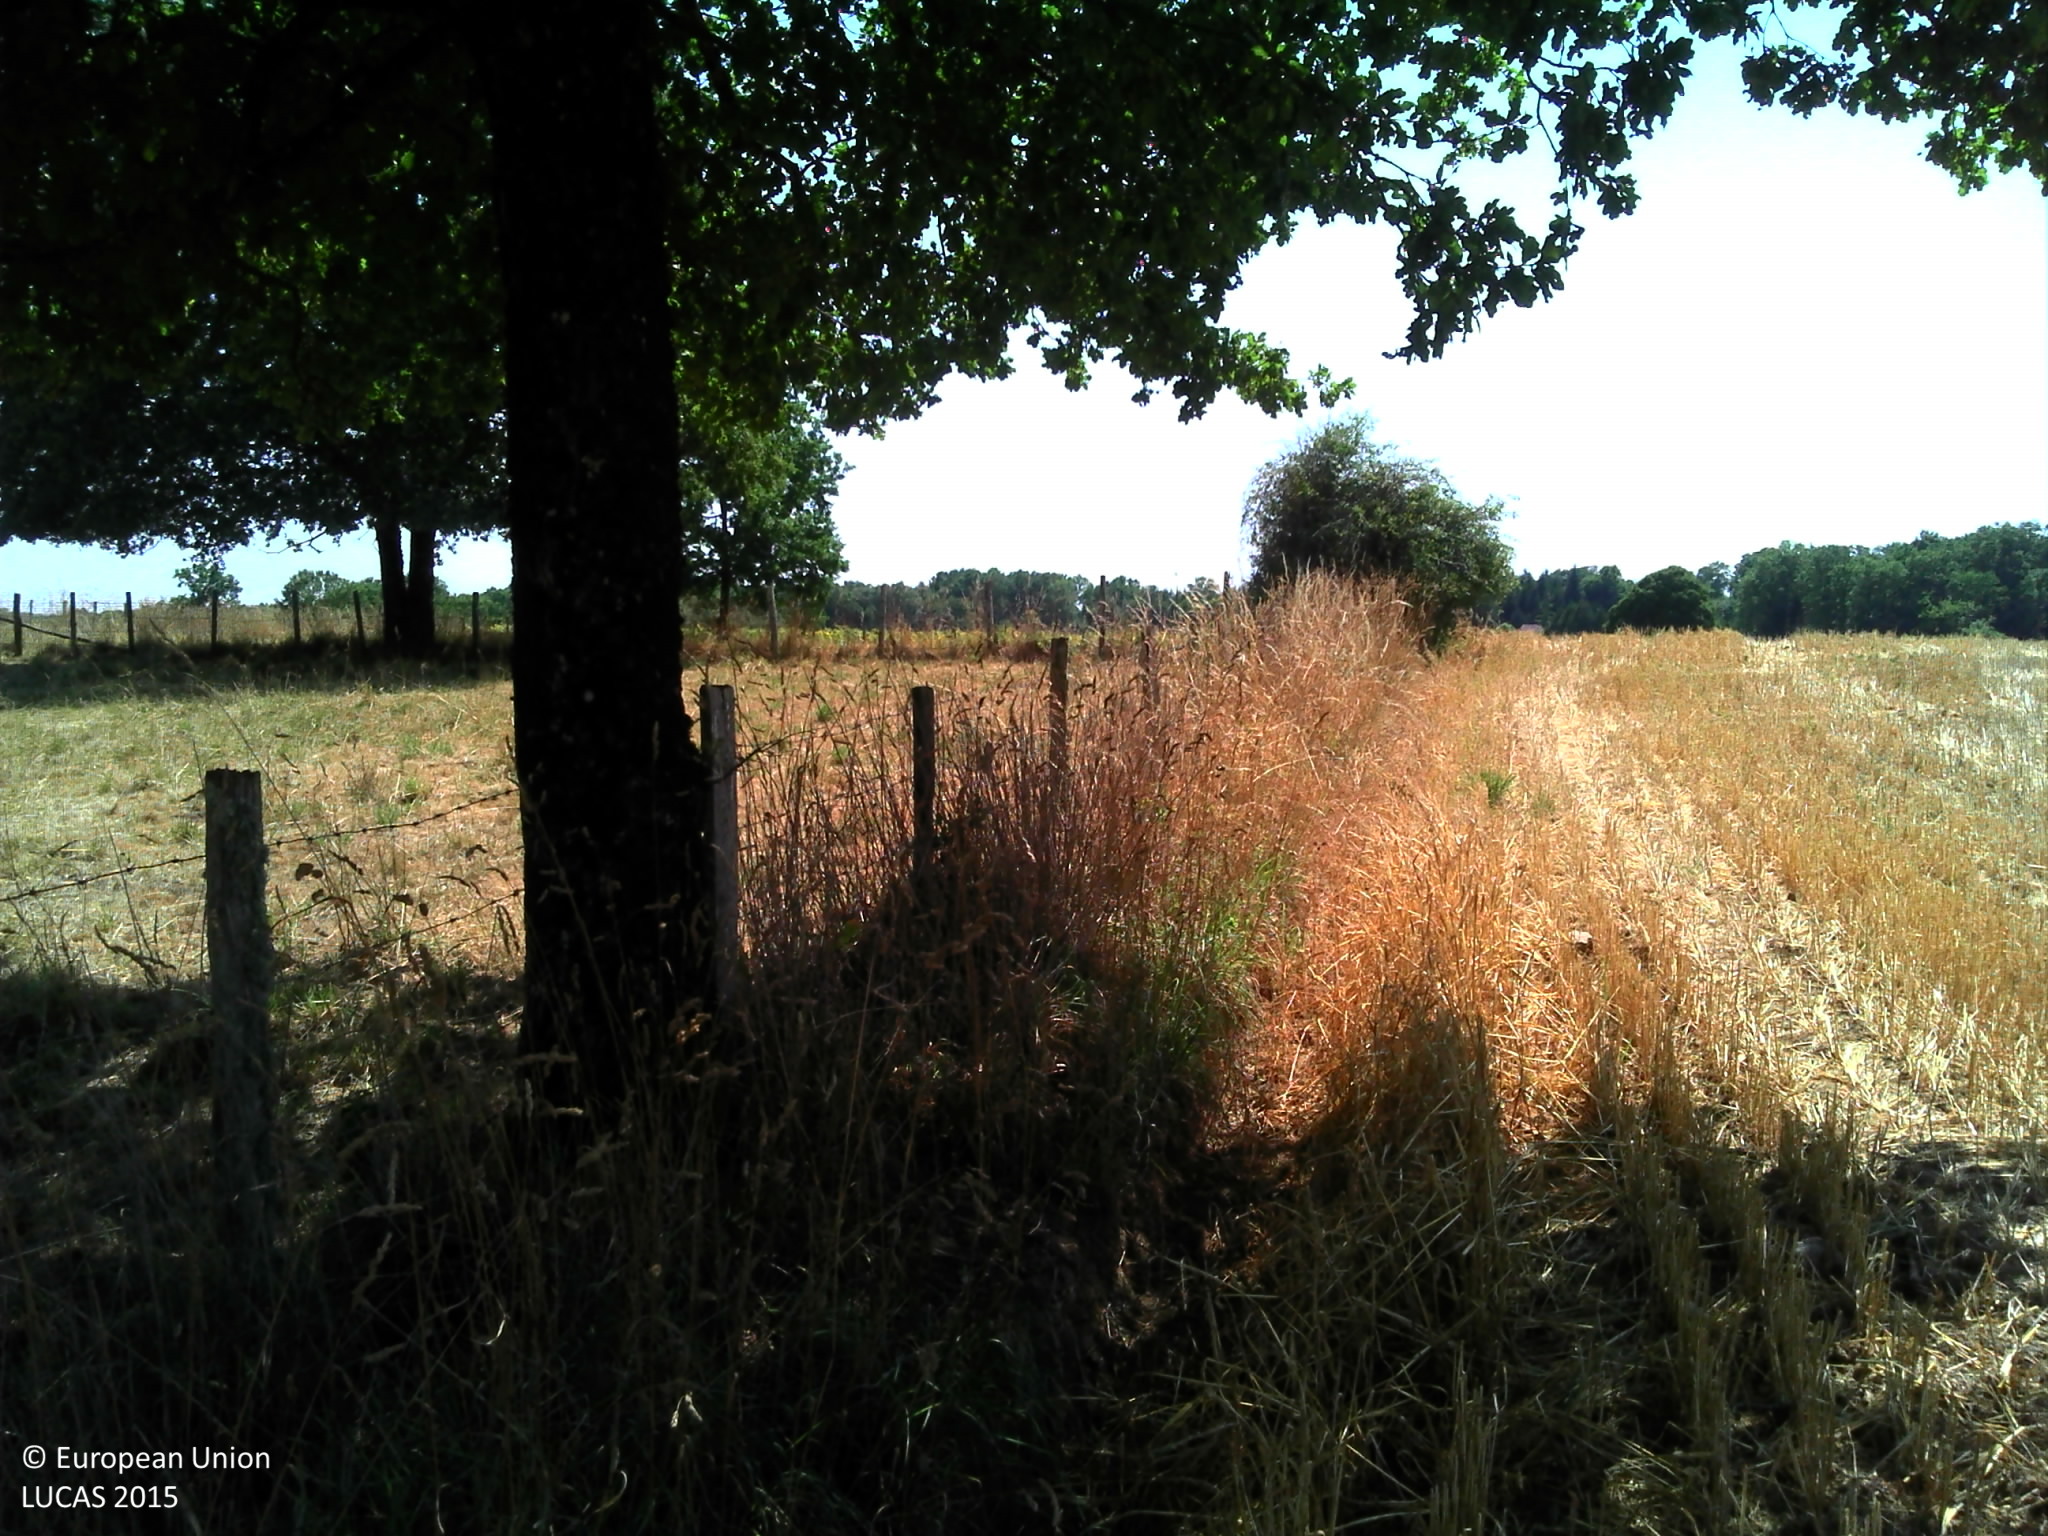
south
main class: Grassland
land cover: Grassland with sparse tree/shrub cover
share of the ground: > 75 %
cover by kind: herbaceous plants 90 %, broadleaved forest trees 5 %, unconsolidated bare surface 5 %
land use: Agriculture (excluding fallow land and kitchen gardens)
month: August
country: FR
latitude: 45.3787
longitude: 1.0651
